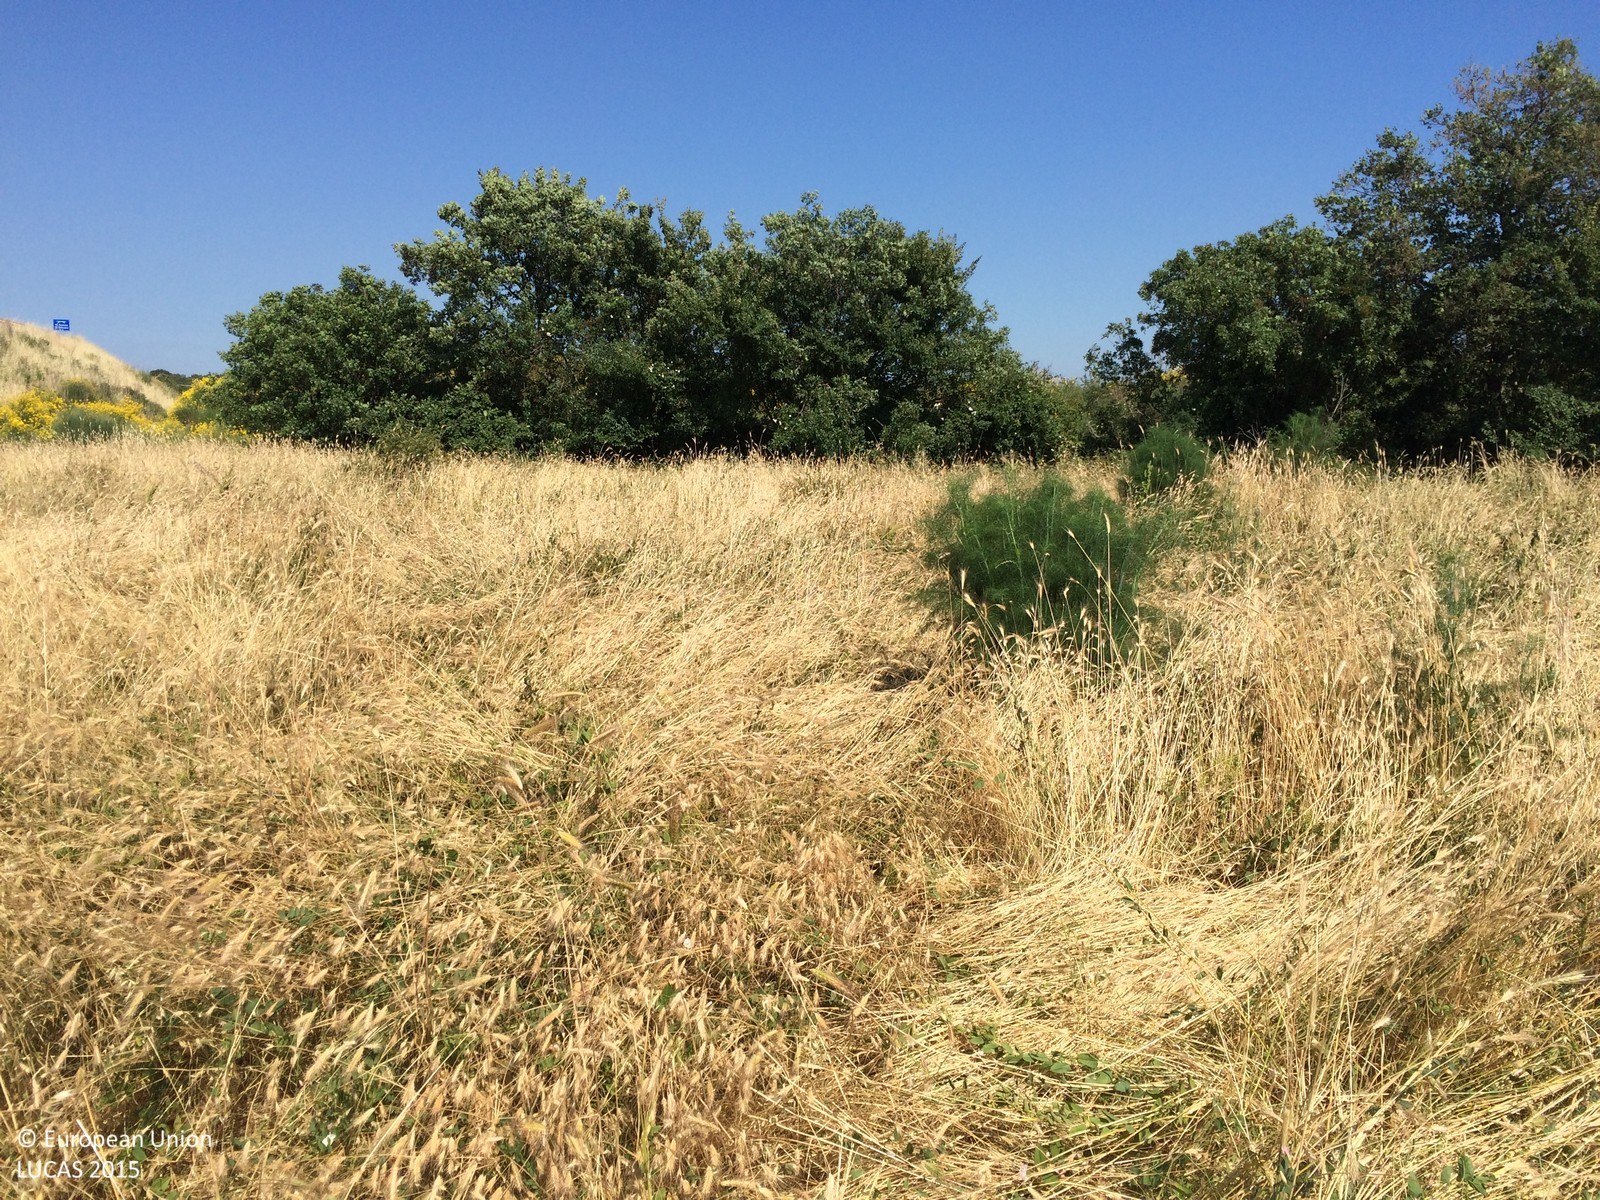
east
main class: Grassland
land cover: Grassland without tree/shrub cover
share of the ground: > 75 %
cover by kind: herbaceous plants 95 %, shrubs 5 %
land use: Semi-natural and natural areas not in use
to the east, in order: Grassland without tree/shrub cover; Shrubland with sparse tree cover; Dry stone walls; Shrubland with sparse tree cover; Shrubland without tree cover; Shrubland with sparse tree cover; Grassland with sparse tree/shrub cover; Shrubland with sparse tree cover; Grassland with sparse tree/shrub cover; Grassland without tree/shrub cover; Shrubland with sparse tree cover; Grass margins; Paved roads, cycling and walking lanes; Grass margins; Dry stone walls; Olive groves; Dry stone walls; Electric lines; Grass margins; Railways
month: June
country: HR
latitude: 44.9467
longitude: 13.8598
